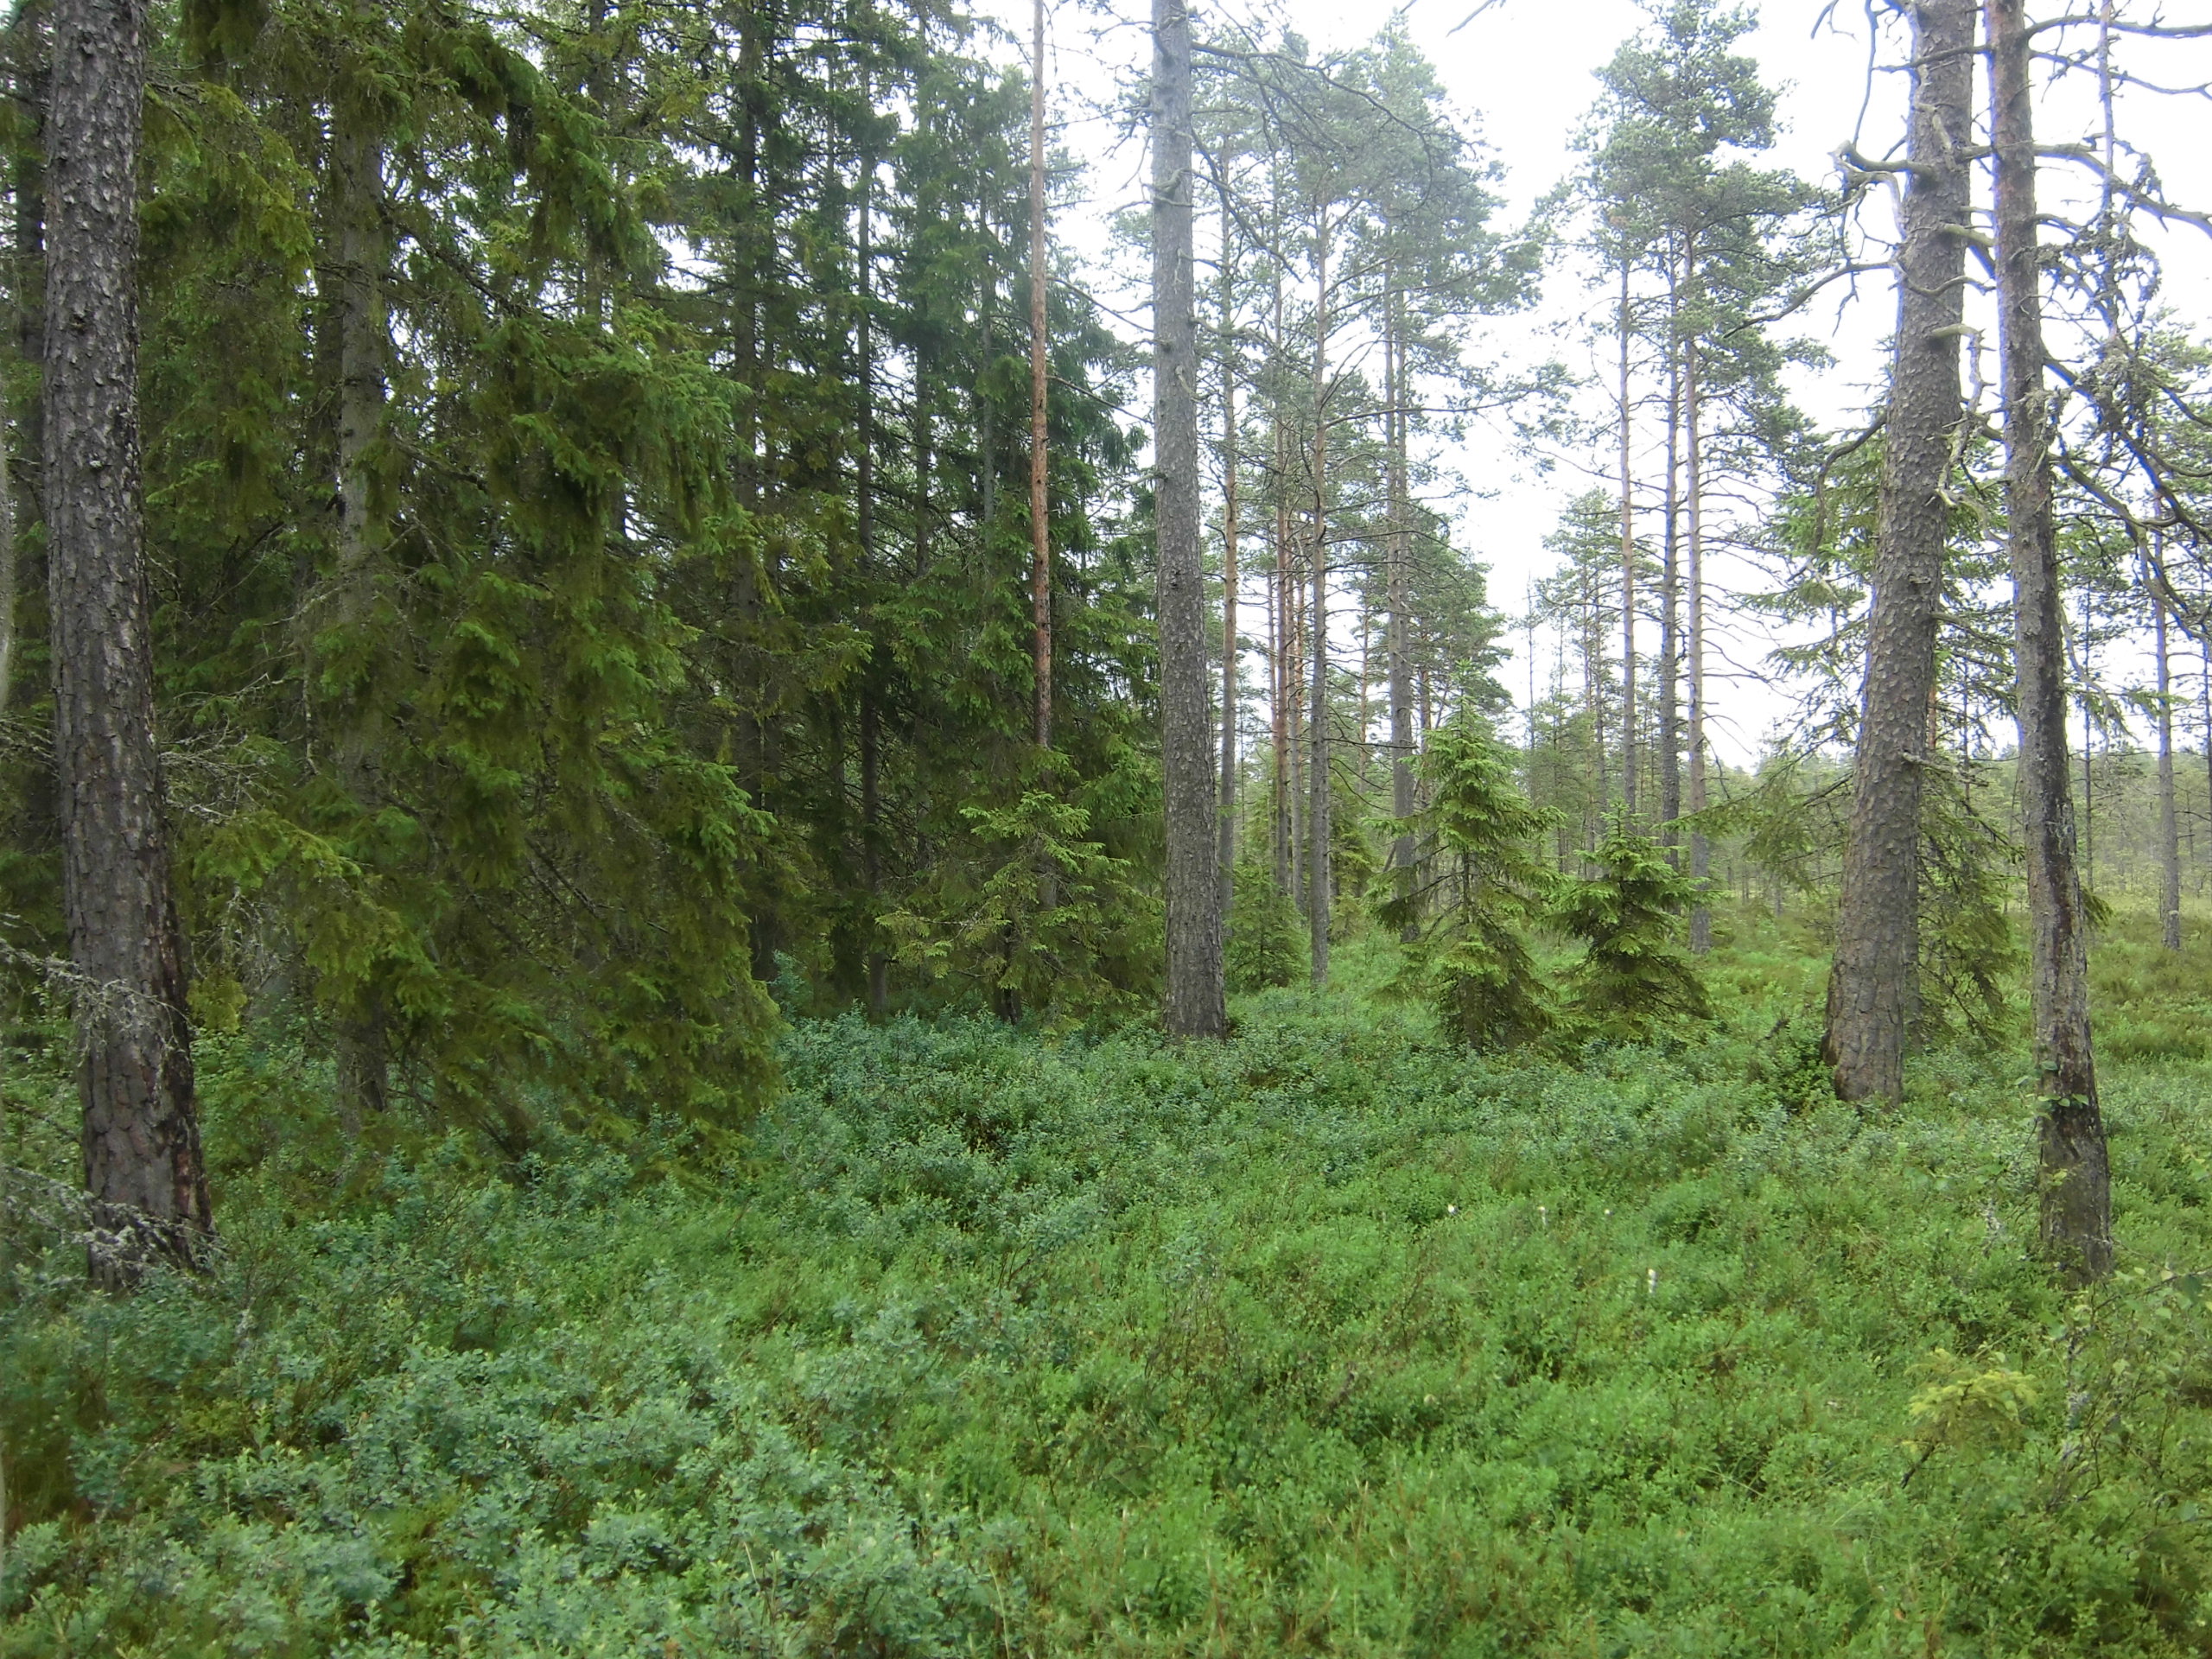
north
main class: Woodland
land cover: Pine dominated coniferous woodland
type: boreal forest
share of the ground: 50 - 75 %
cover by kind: coniferous forest trees 50 %, shrubs 25 %, herbaceous plants 15 %, lichens and mosses 10 %
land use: Forestry
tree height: > 5 m
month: July
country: SE
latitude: 57.2351
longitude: 15.2157
